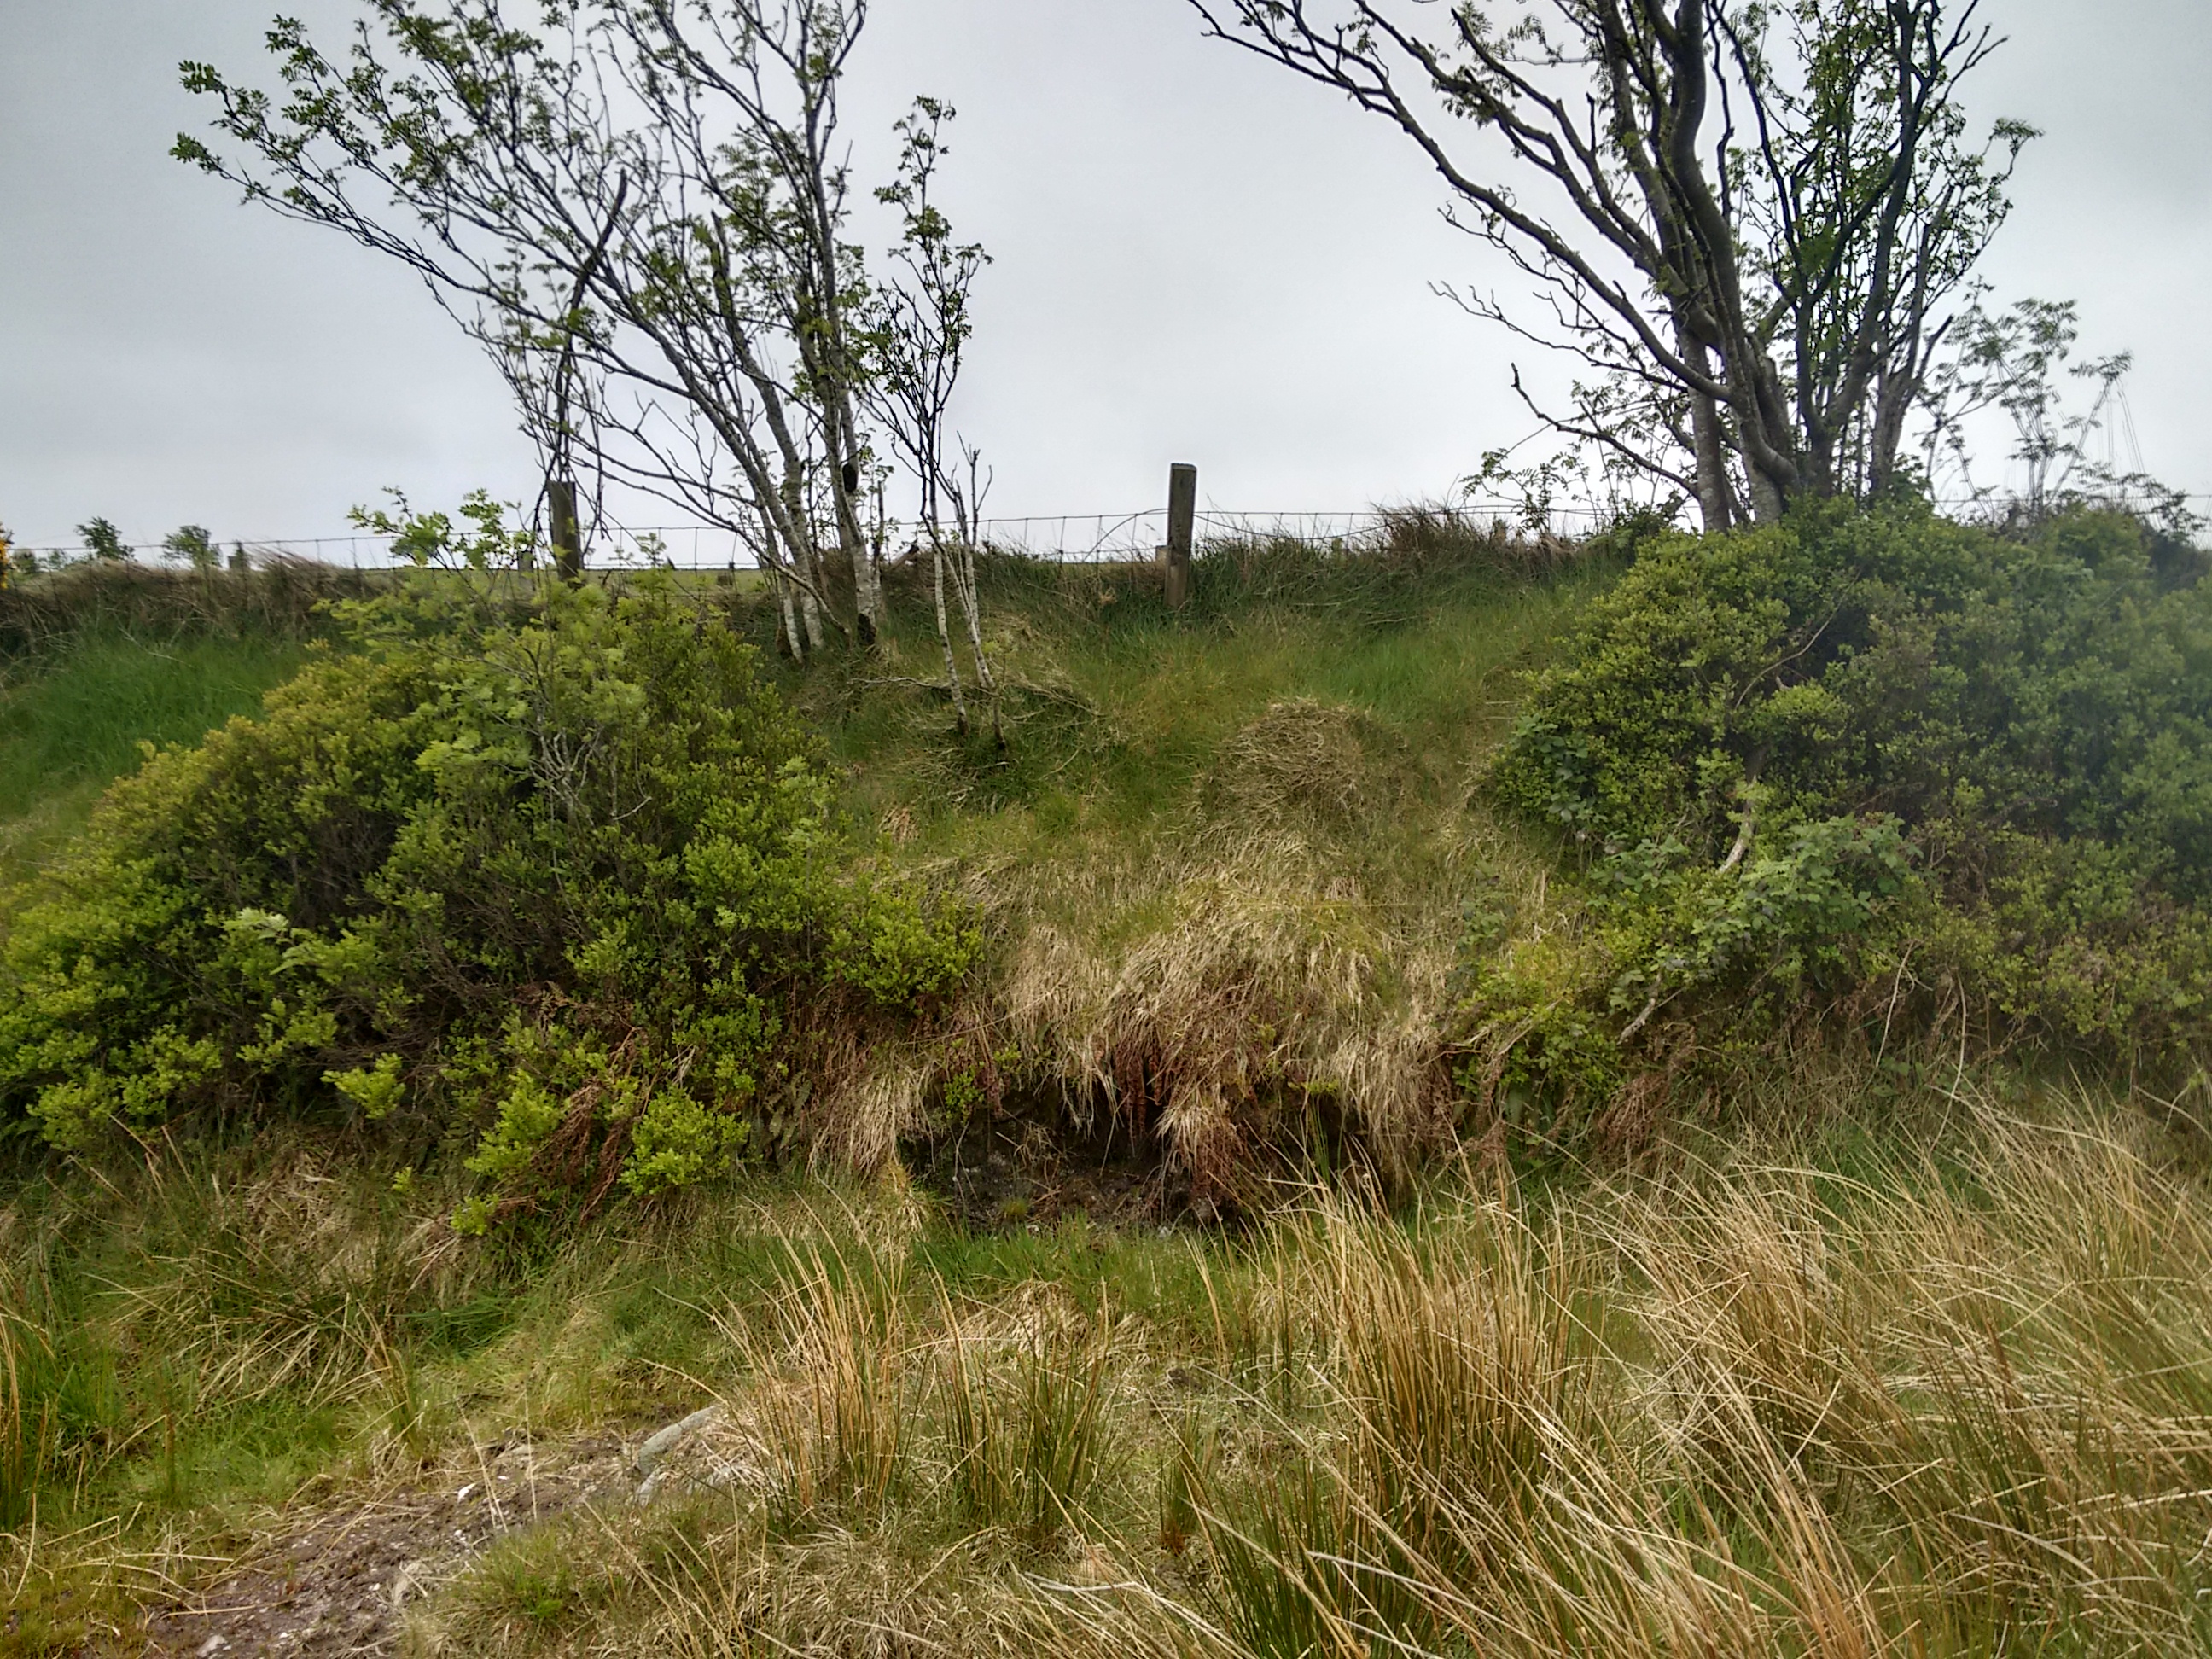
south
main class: Grassland
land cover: Grassland without tree/shrub cover
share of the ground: > 75 %
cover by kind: herbaceous plants 100 %
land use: Agriculture (excluding fallow land and kitchen gardens)
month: May
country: GB
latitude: 54.9984
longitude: -7.0376
